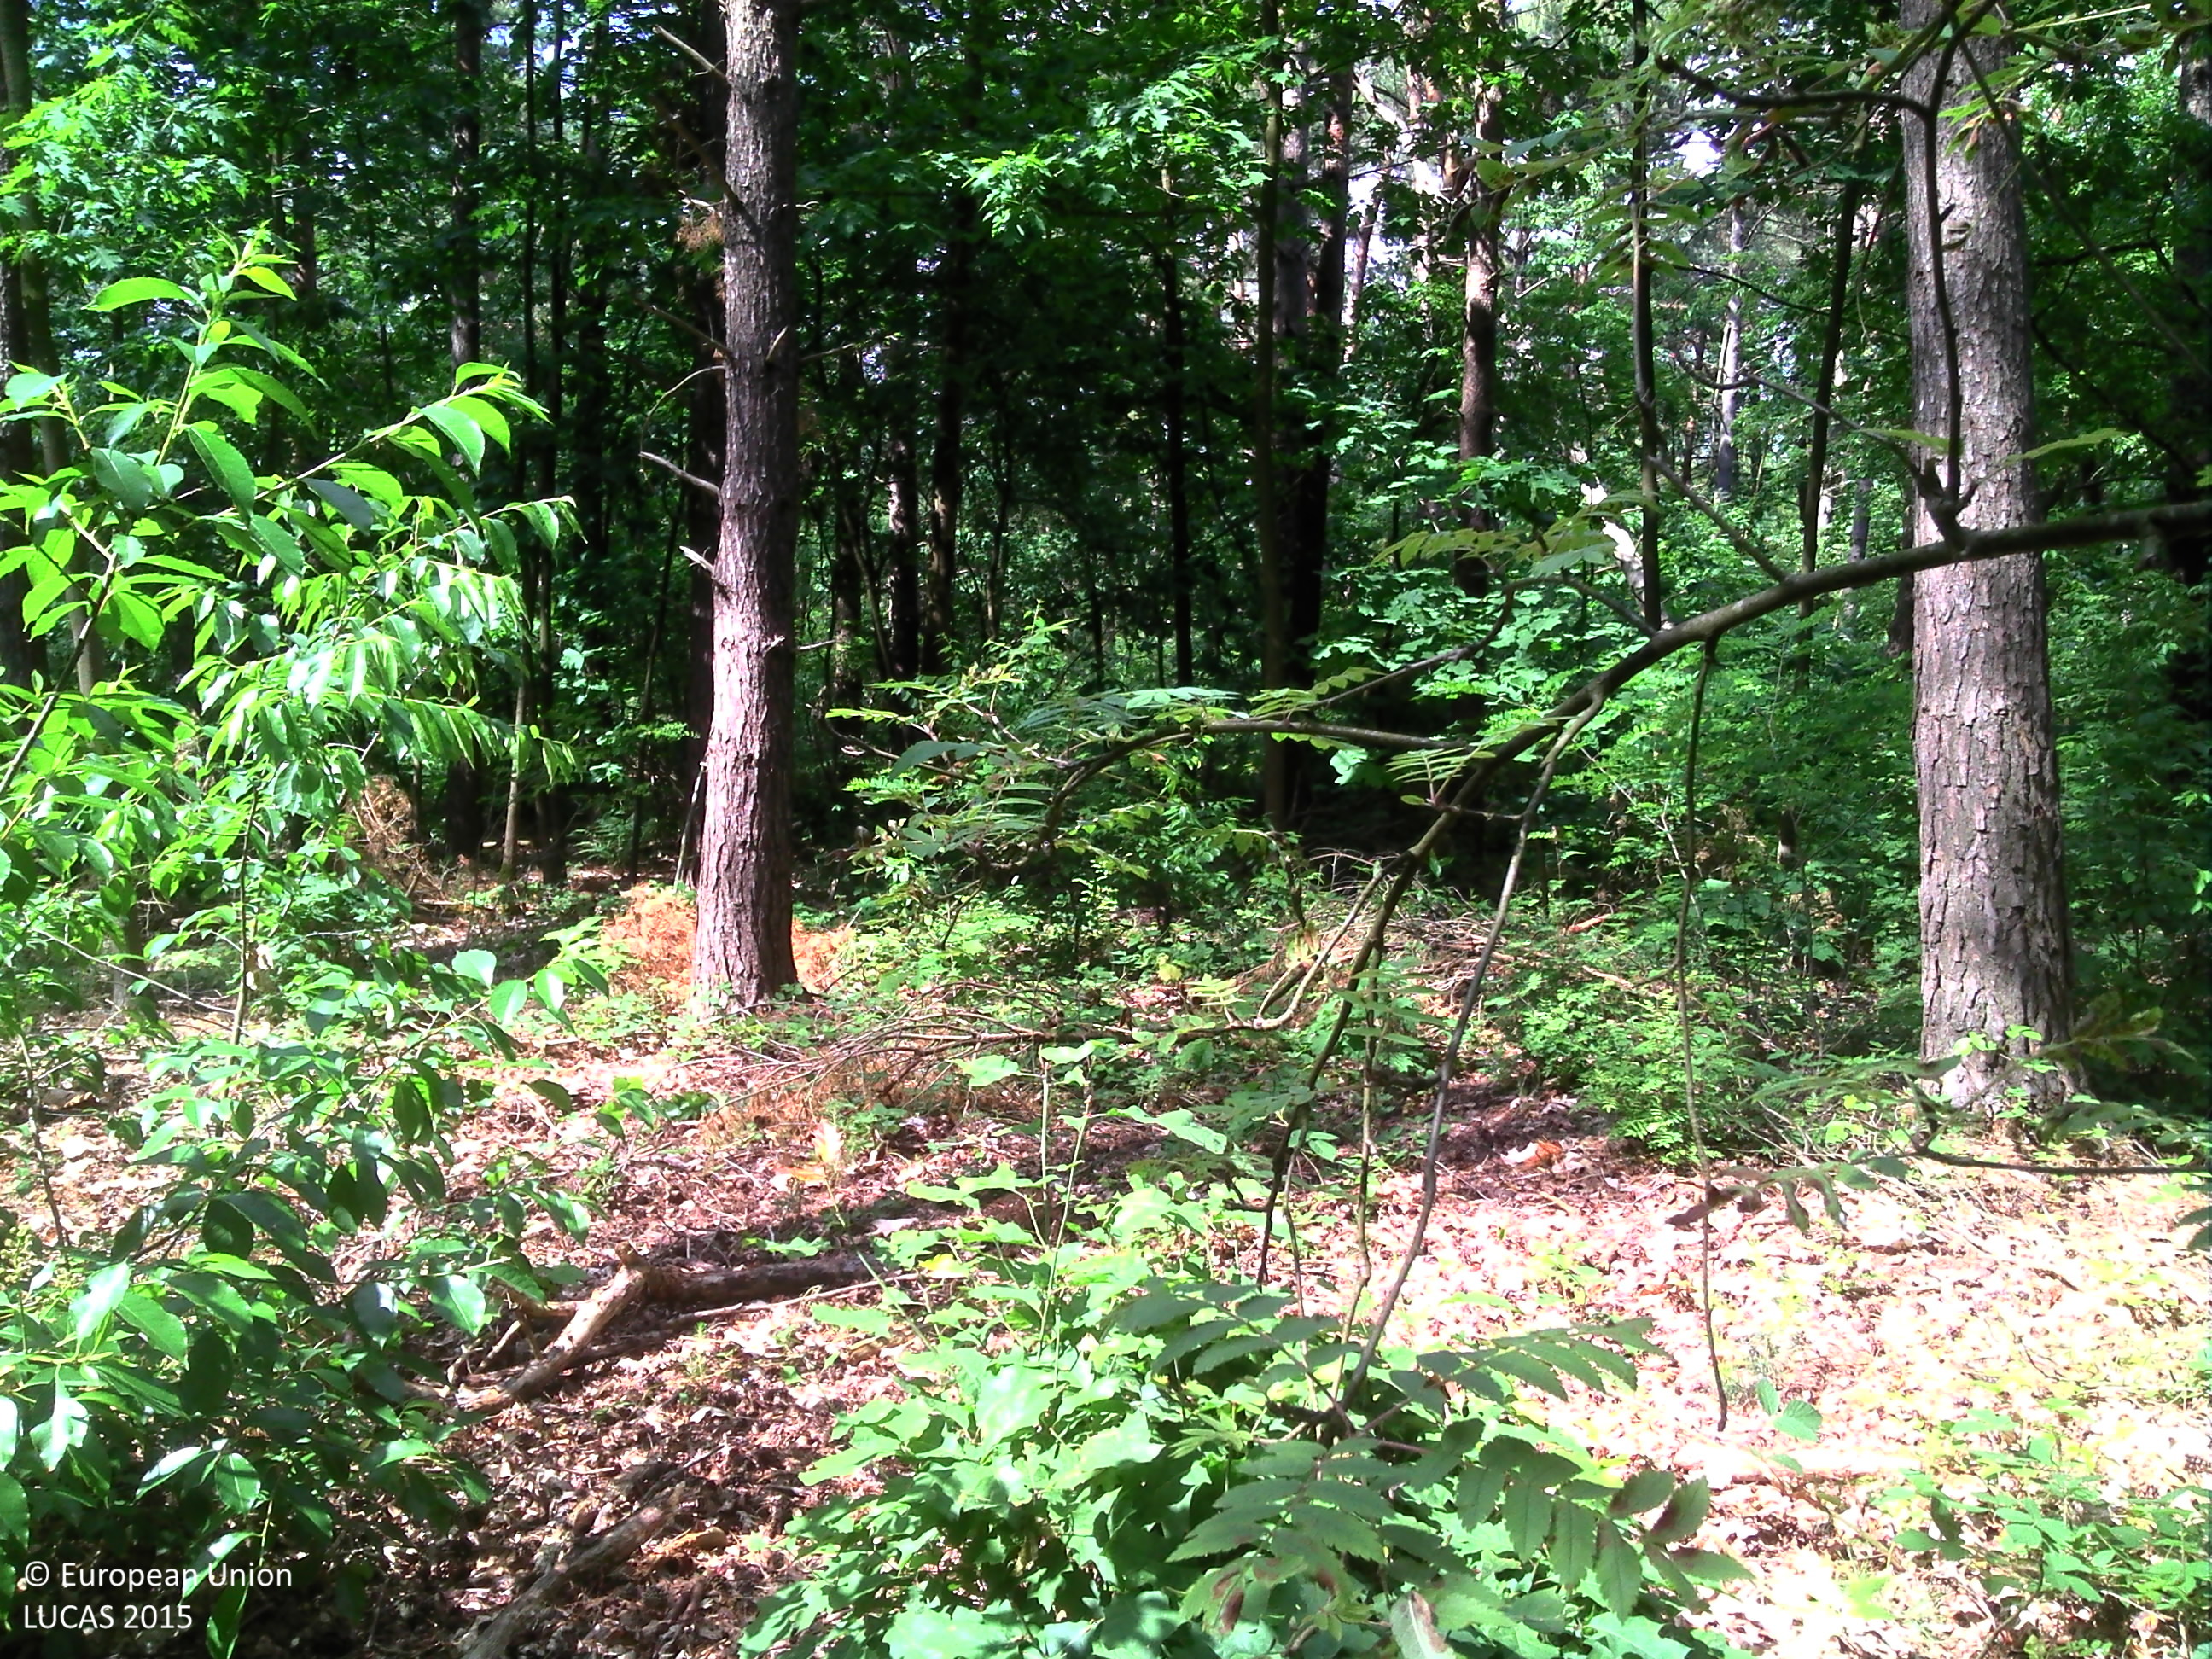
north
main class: Woodland
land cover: Pine dominated mixed woodland
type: exotic forest
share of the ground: > 75 %
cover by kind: broadleaved forest trees 70 %, coniferous forest trees 25 %, herbaceous plants 5 %
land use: Forestry
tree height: > 5 m
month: June
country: BE
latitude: 51.0756
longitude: 5.7023
